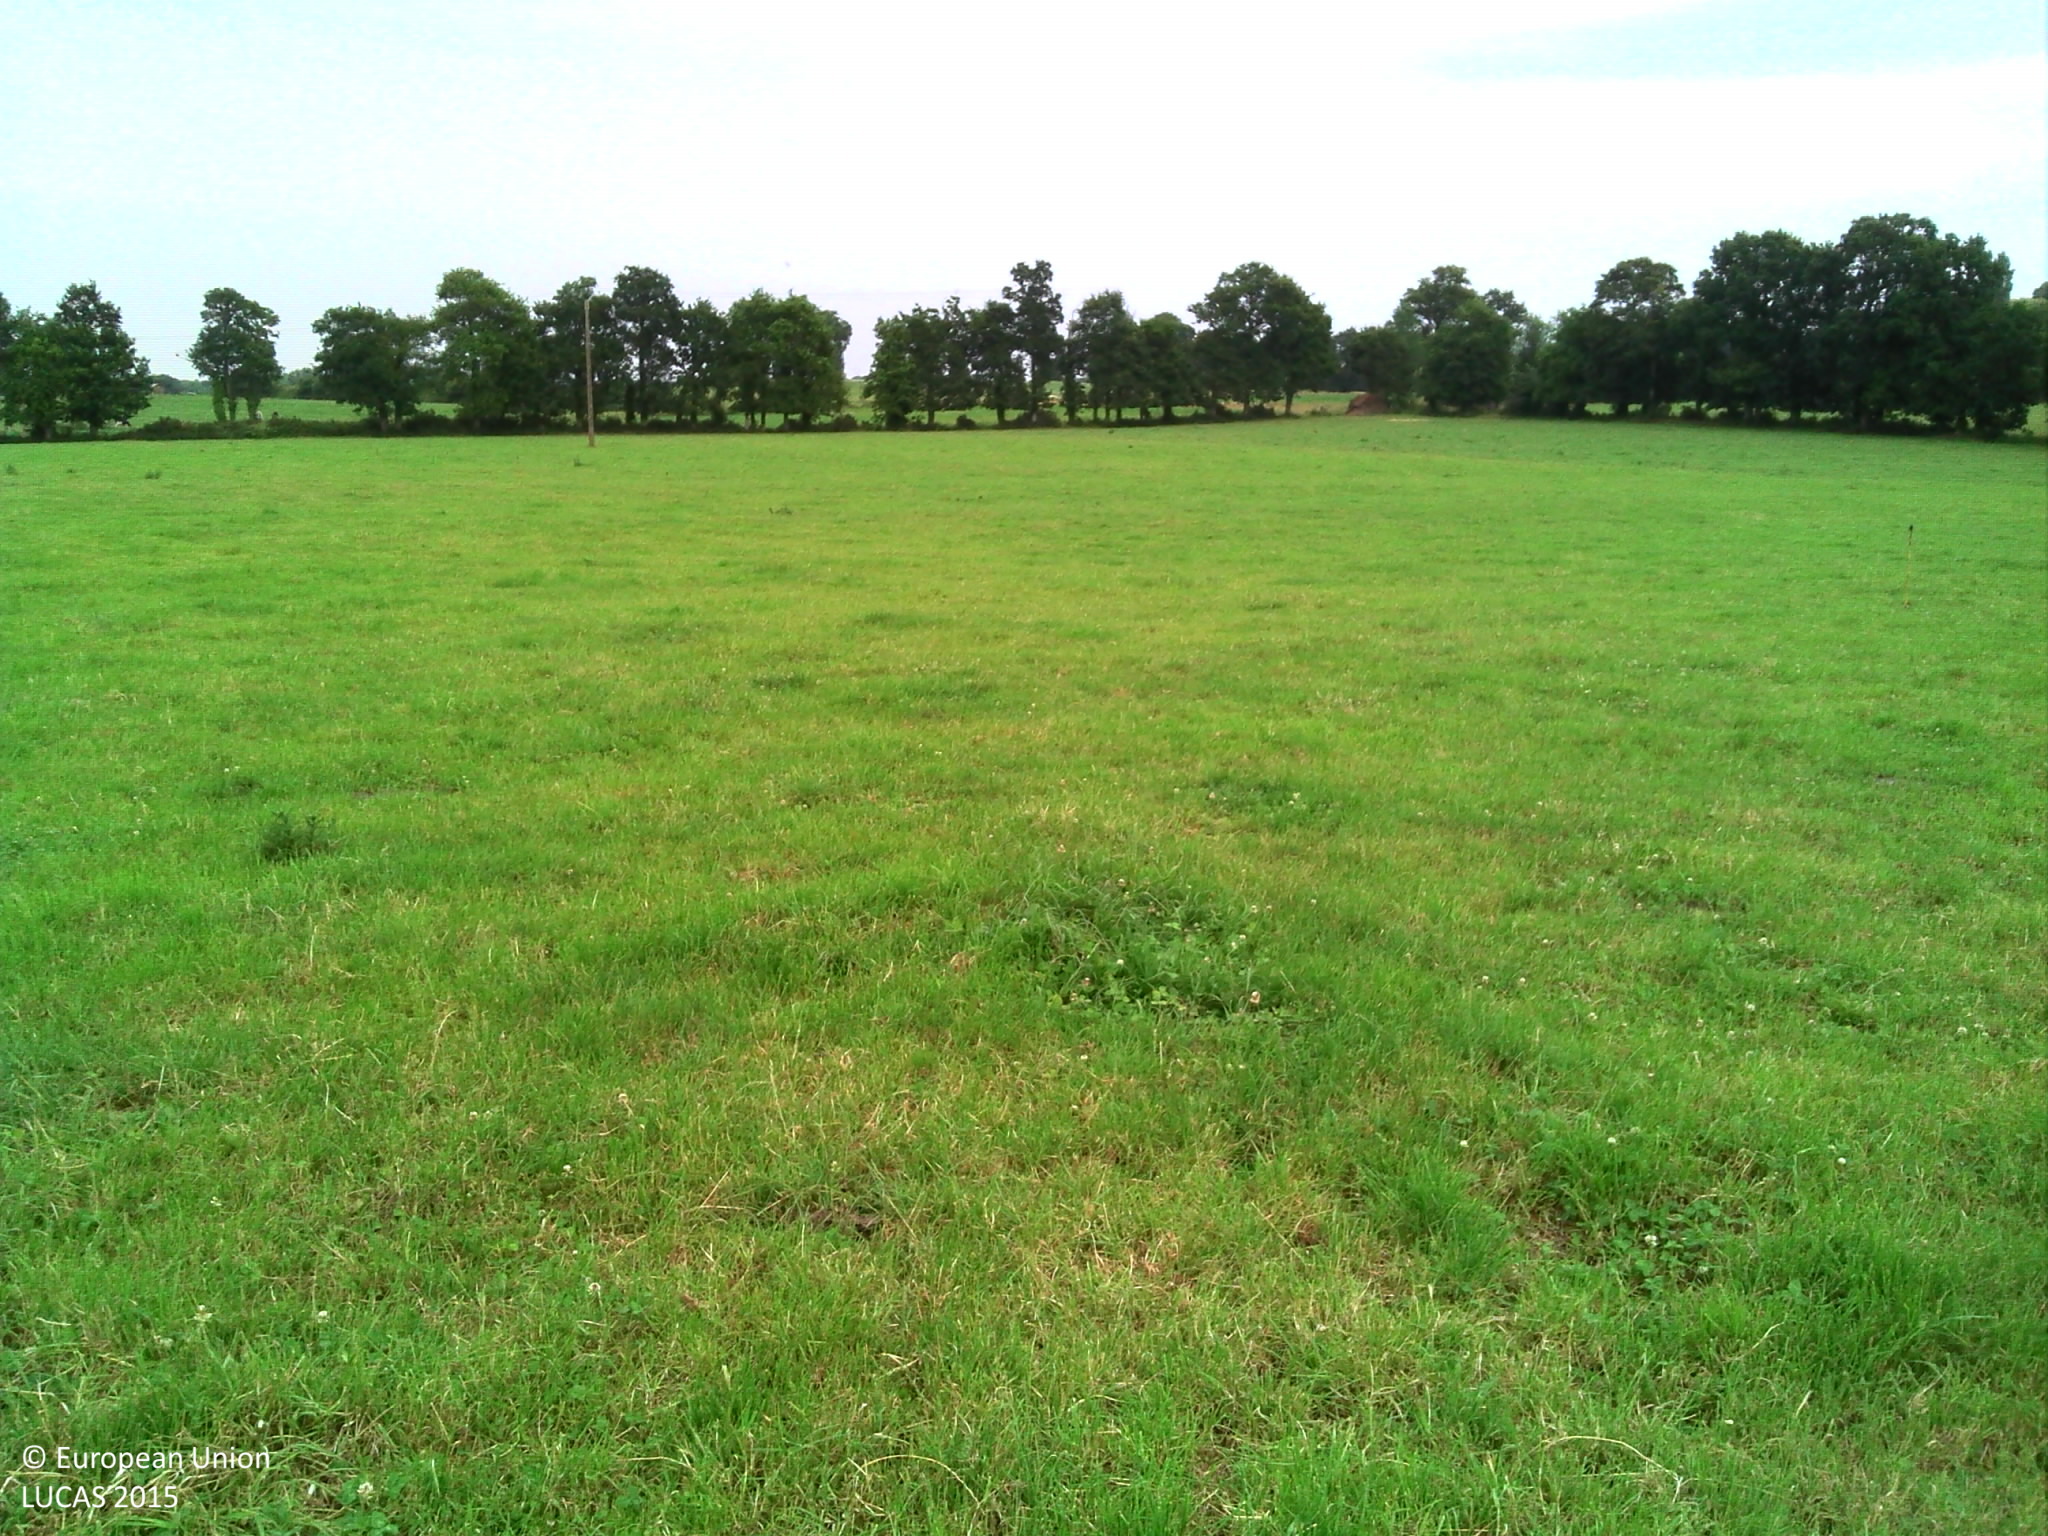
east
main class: Grassland
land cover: Grassland without tree/shrub cover
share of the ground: > 75 %
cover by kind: herbaceous plants 100 %
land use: Agriculture (excluding fallow land and kitchen gardens)
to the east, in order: Grassland without tree/shrub cover; Fences; Grassland without tree/shrub cover; Electric lines; Grassland without tree/shrub cover; Fences; Lines of trees; Ditches and canals; Maize
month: July
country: FR
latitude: 48.5518
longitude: -2.1269
